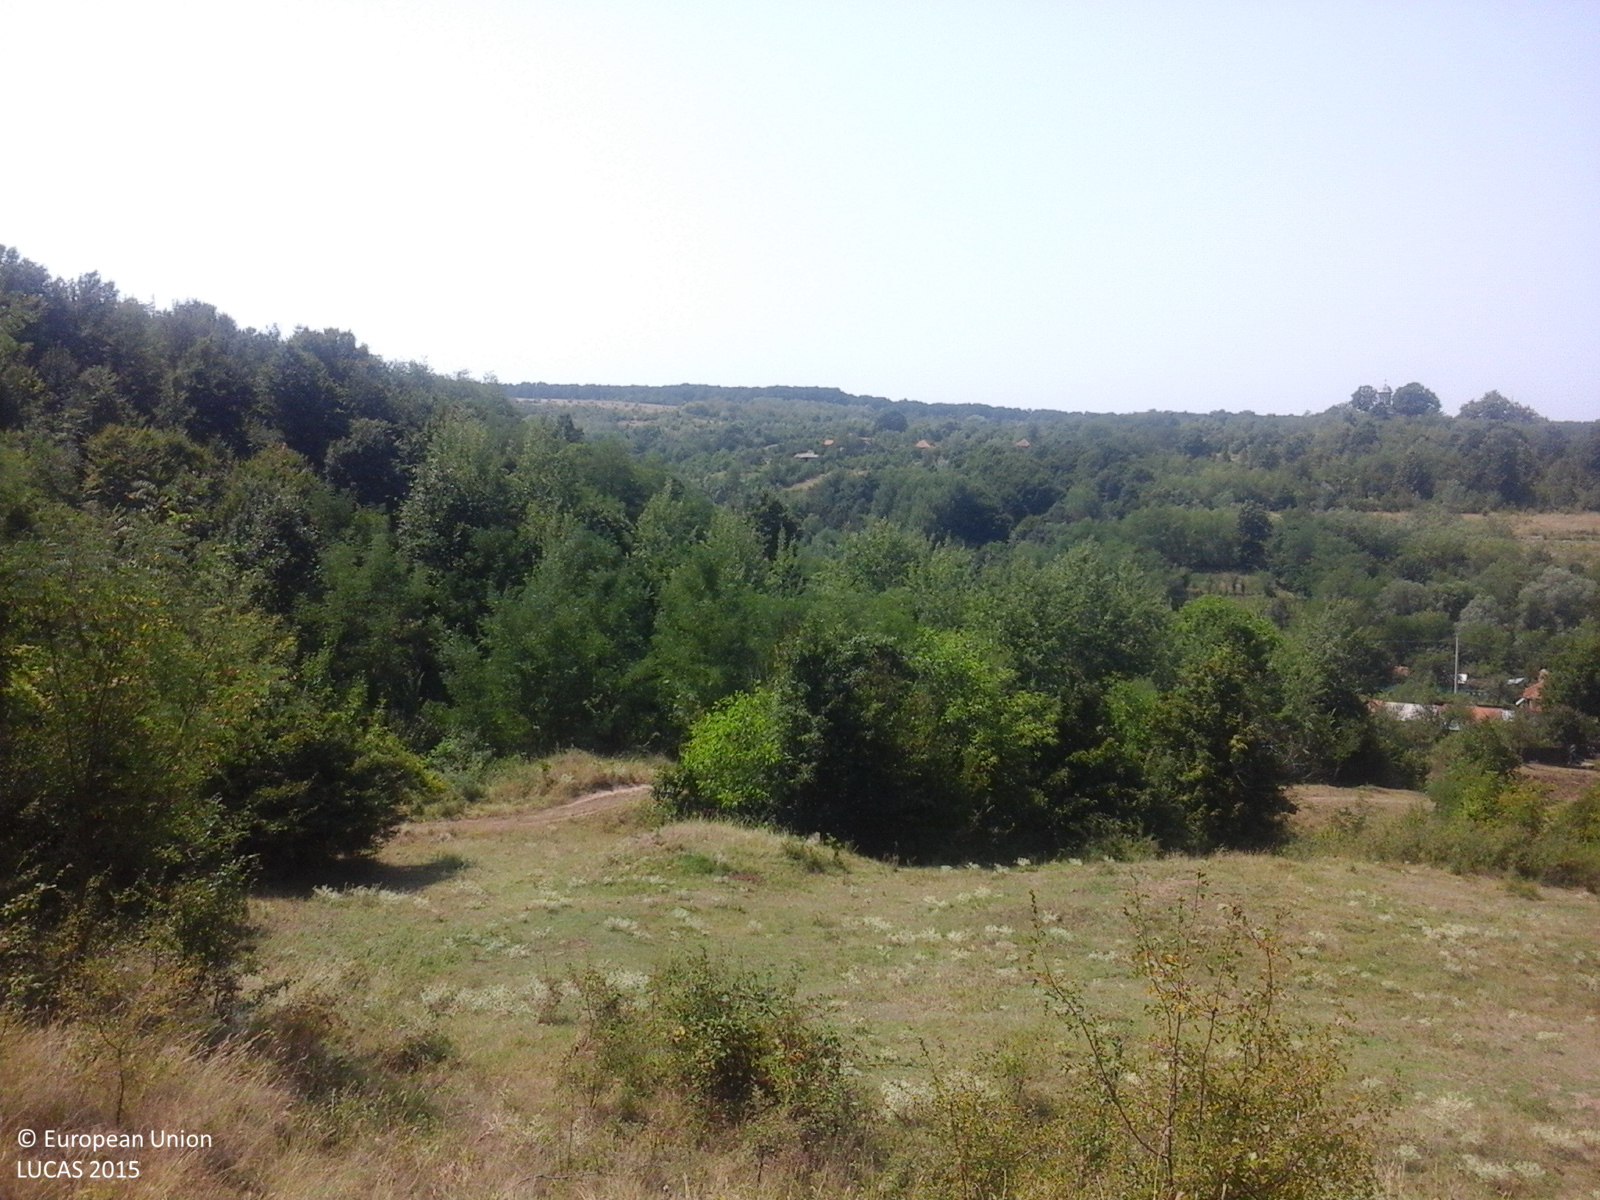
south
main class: Woodland
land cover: Broadleaved woodland
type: acidophilous oak and oak-birch forest
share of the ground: > 75 %
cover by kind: broadleaved forest trees 100 %
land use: Forestry
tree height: > 5 m
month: August
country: RO
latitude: 44.5801
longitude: 23.0568
